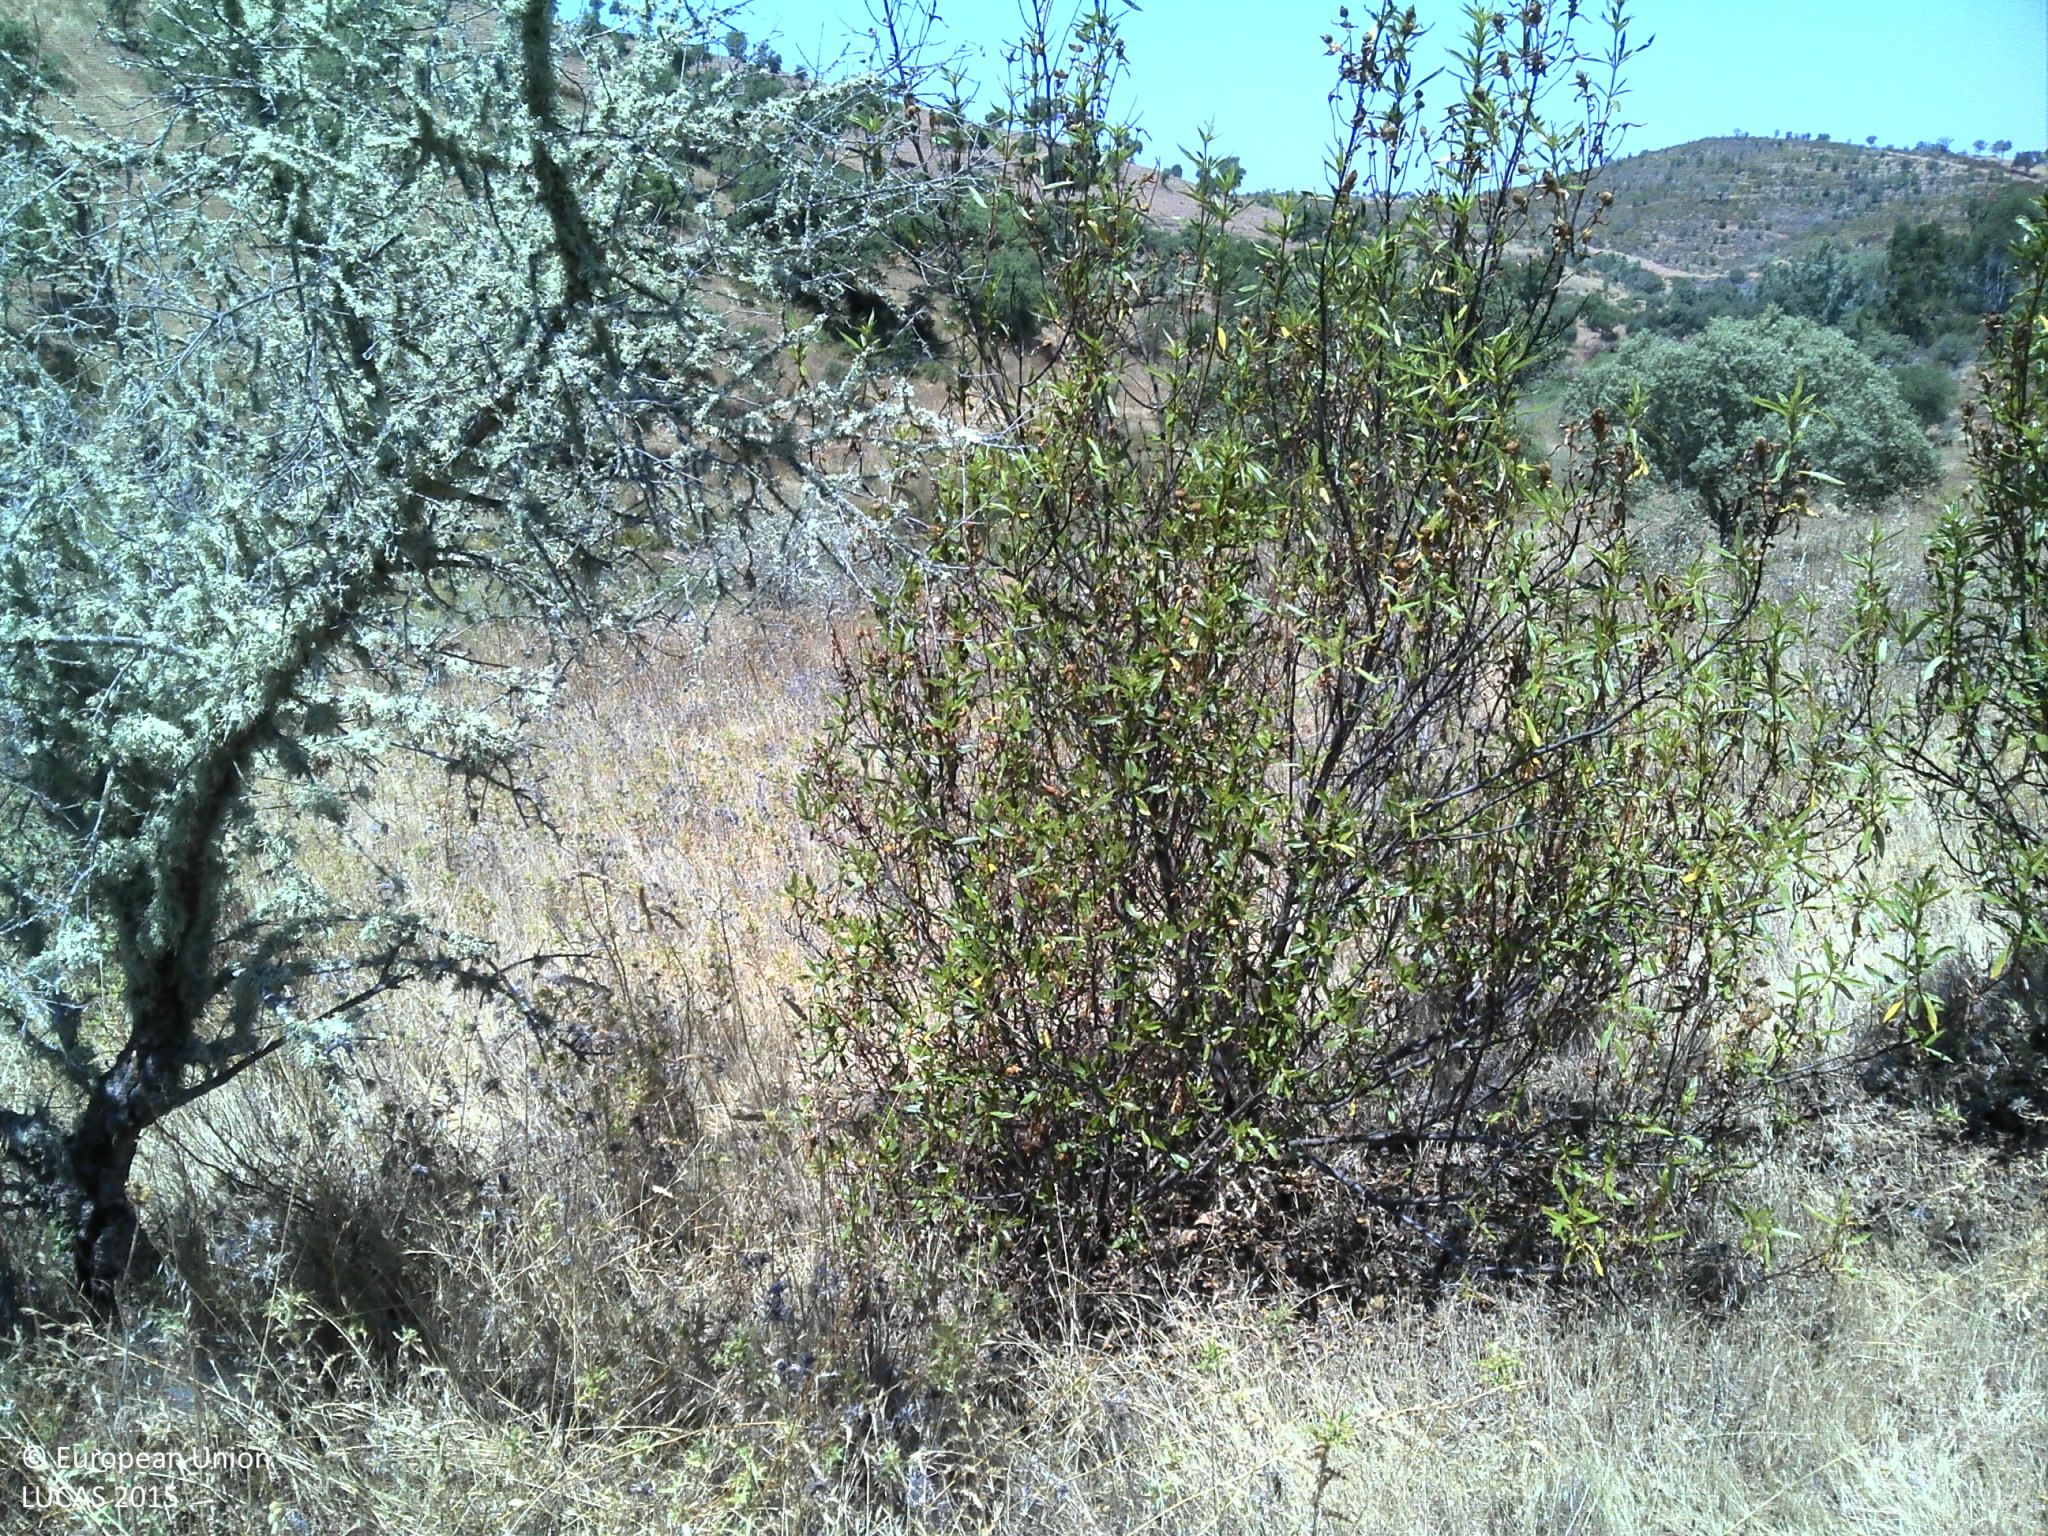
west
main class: Shrubland
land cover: Shrubland with sparse tree cover
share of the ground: 25 - 50 %
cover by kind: shrubs 50 %, herbaceous plants 30 %, unconsolidated bare surface 15 %, broadleaved forest trees 5 %
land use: Agriculture (excluding fallow land and kitchen gardens)
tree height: > 5 m
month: June
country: PT
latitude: 37.8699
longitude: -7.4888
